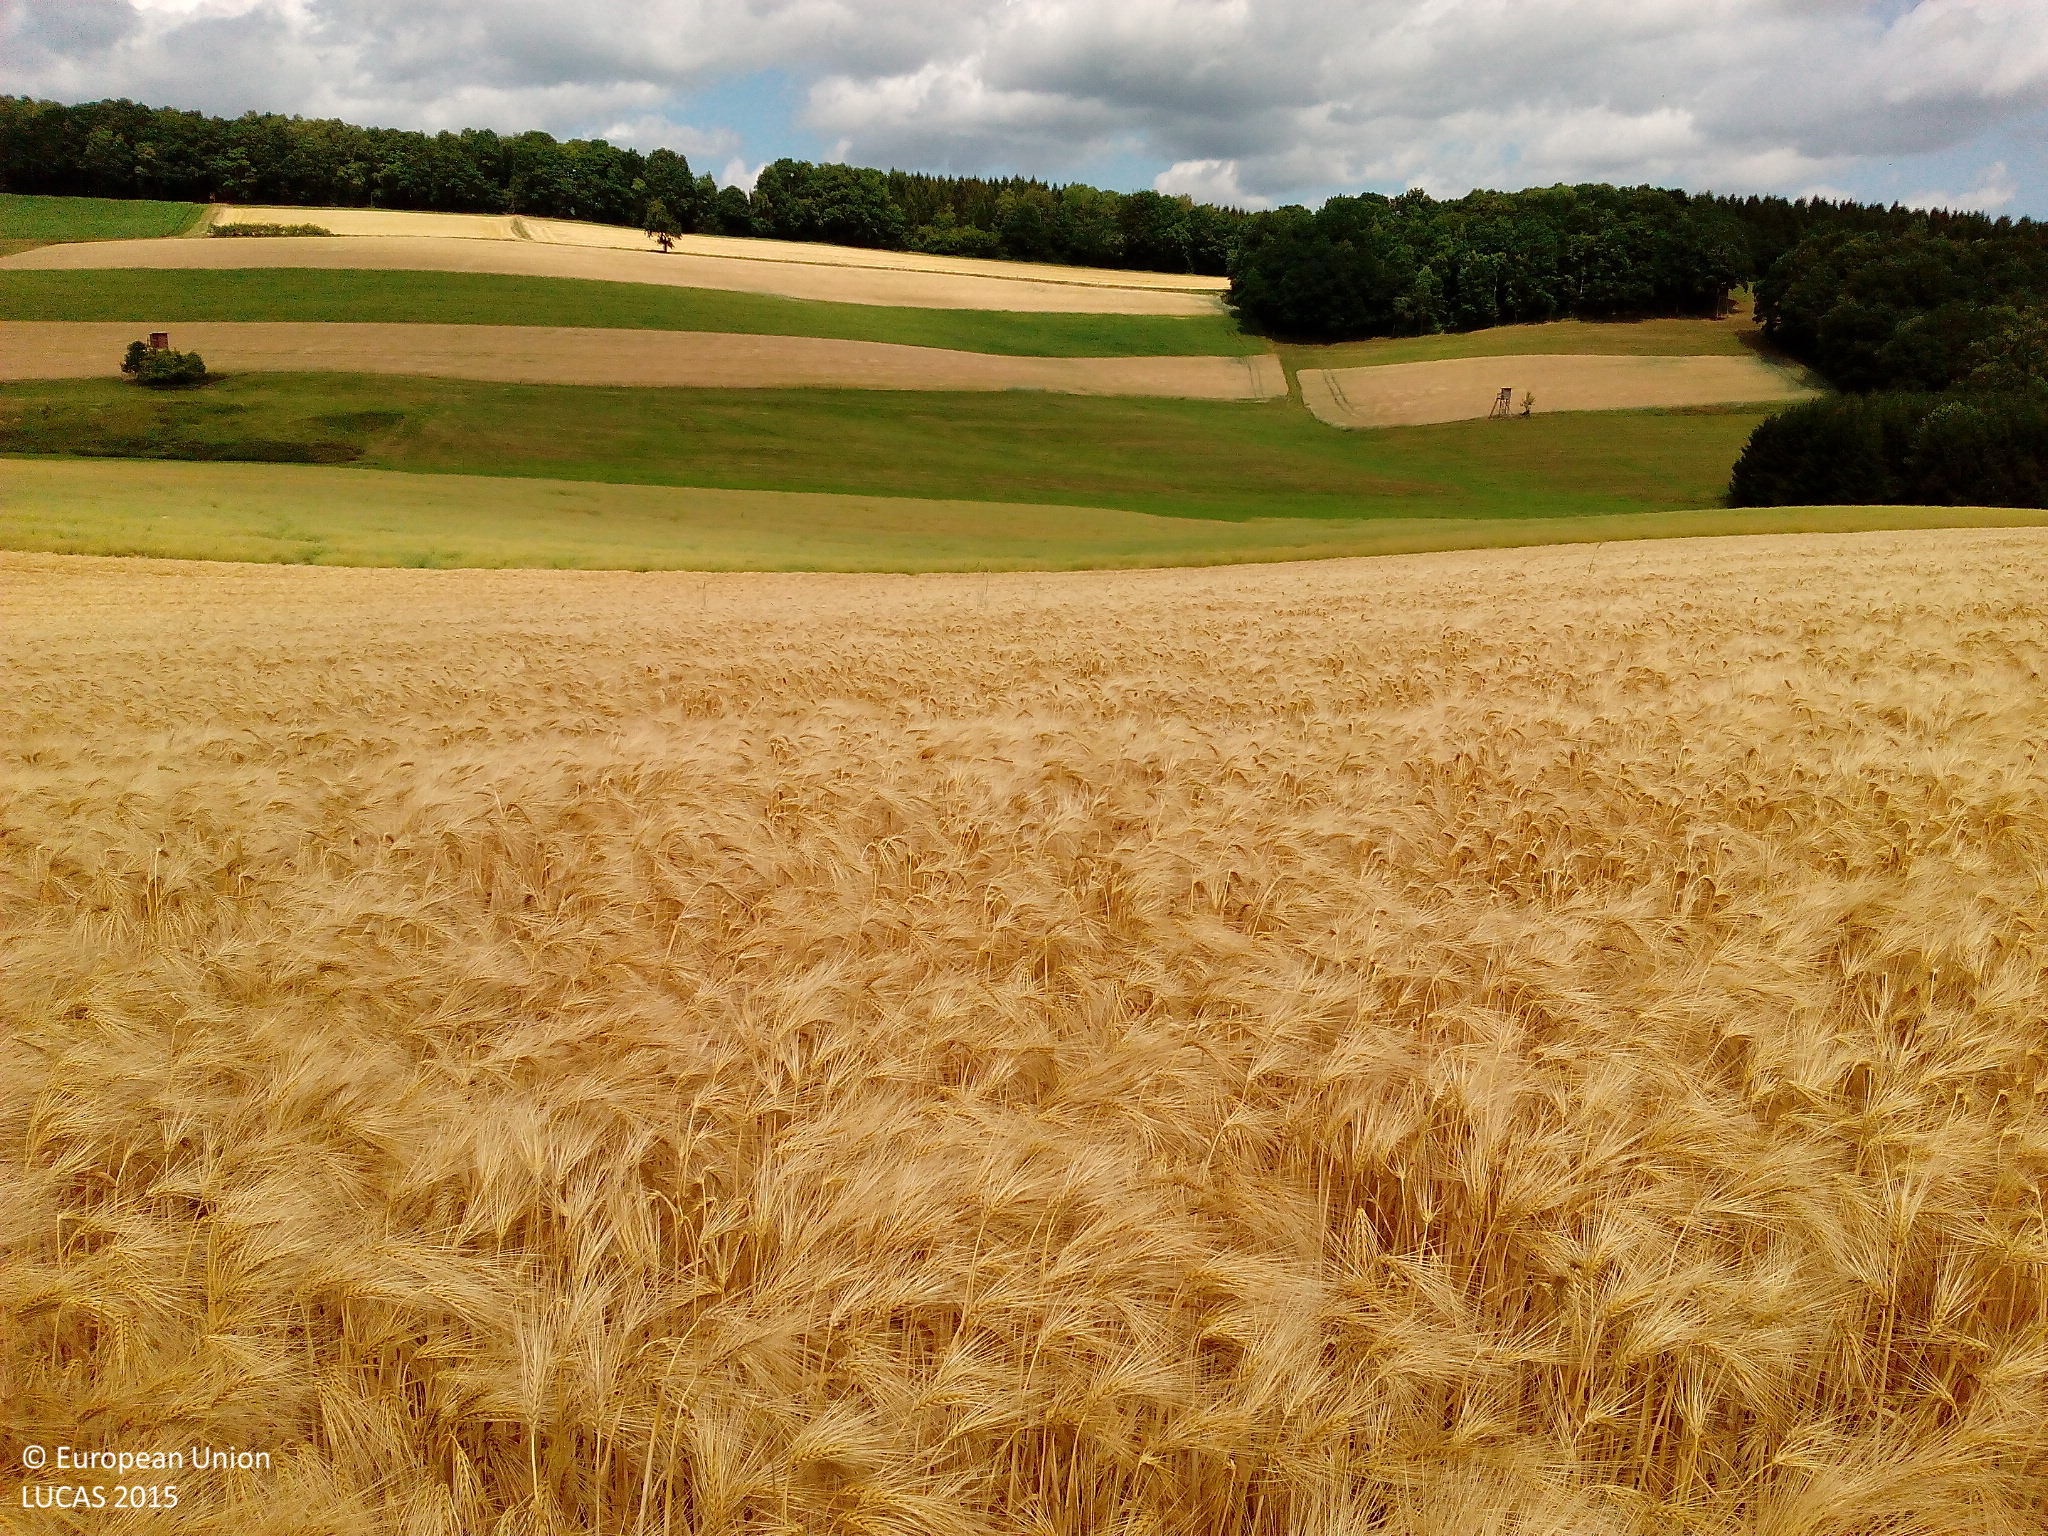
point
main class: Cropland
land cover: Barley
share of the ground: > 75 %
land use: Agriculture (excluding fallow land and kitchen gardens)
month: July
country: DE
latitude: 51.0651
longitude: 9.8431
